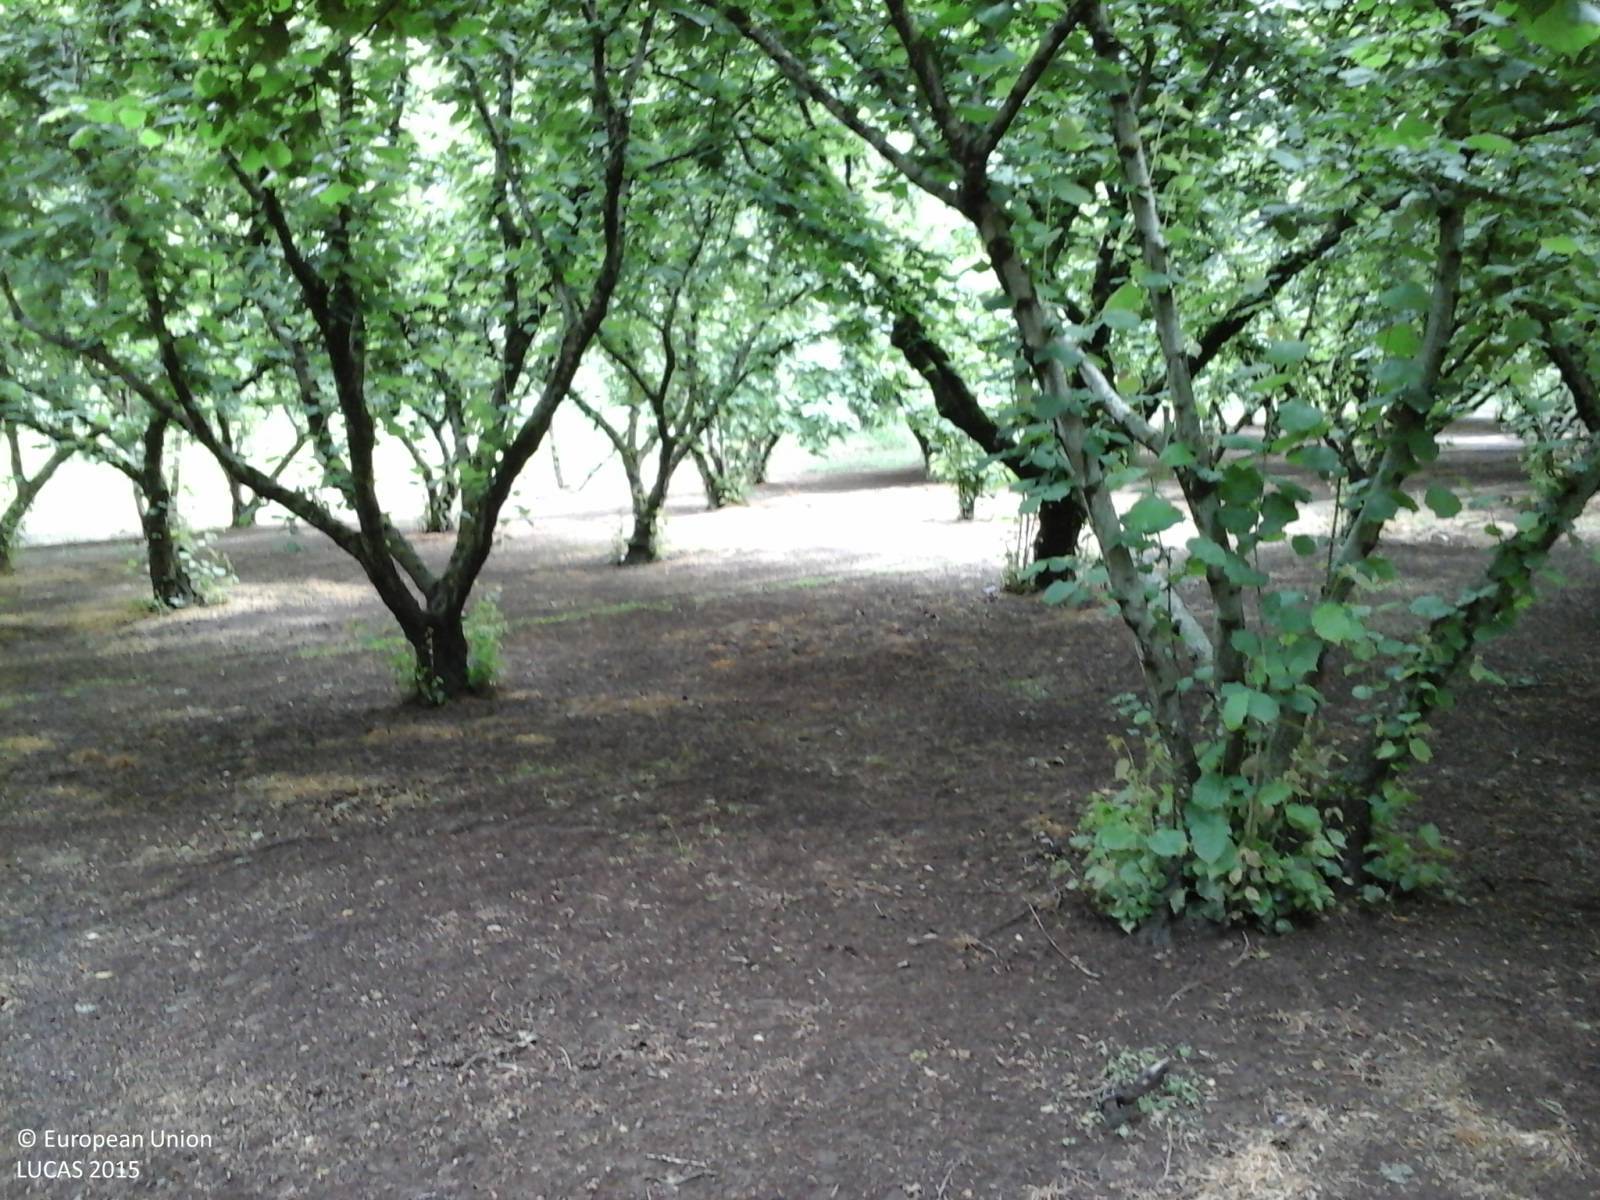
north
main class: Cropland
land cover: Nuts trees
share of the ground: > 75 %
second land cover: Other bare soil
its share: > 75 %
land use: Agriculture (excluding fallow land and kitchen gardens)
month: May
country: IT
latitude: 42.2876
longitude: 12.1633
